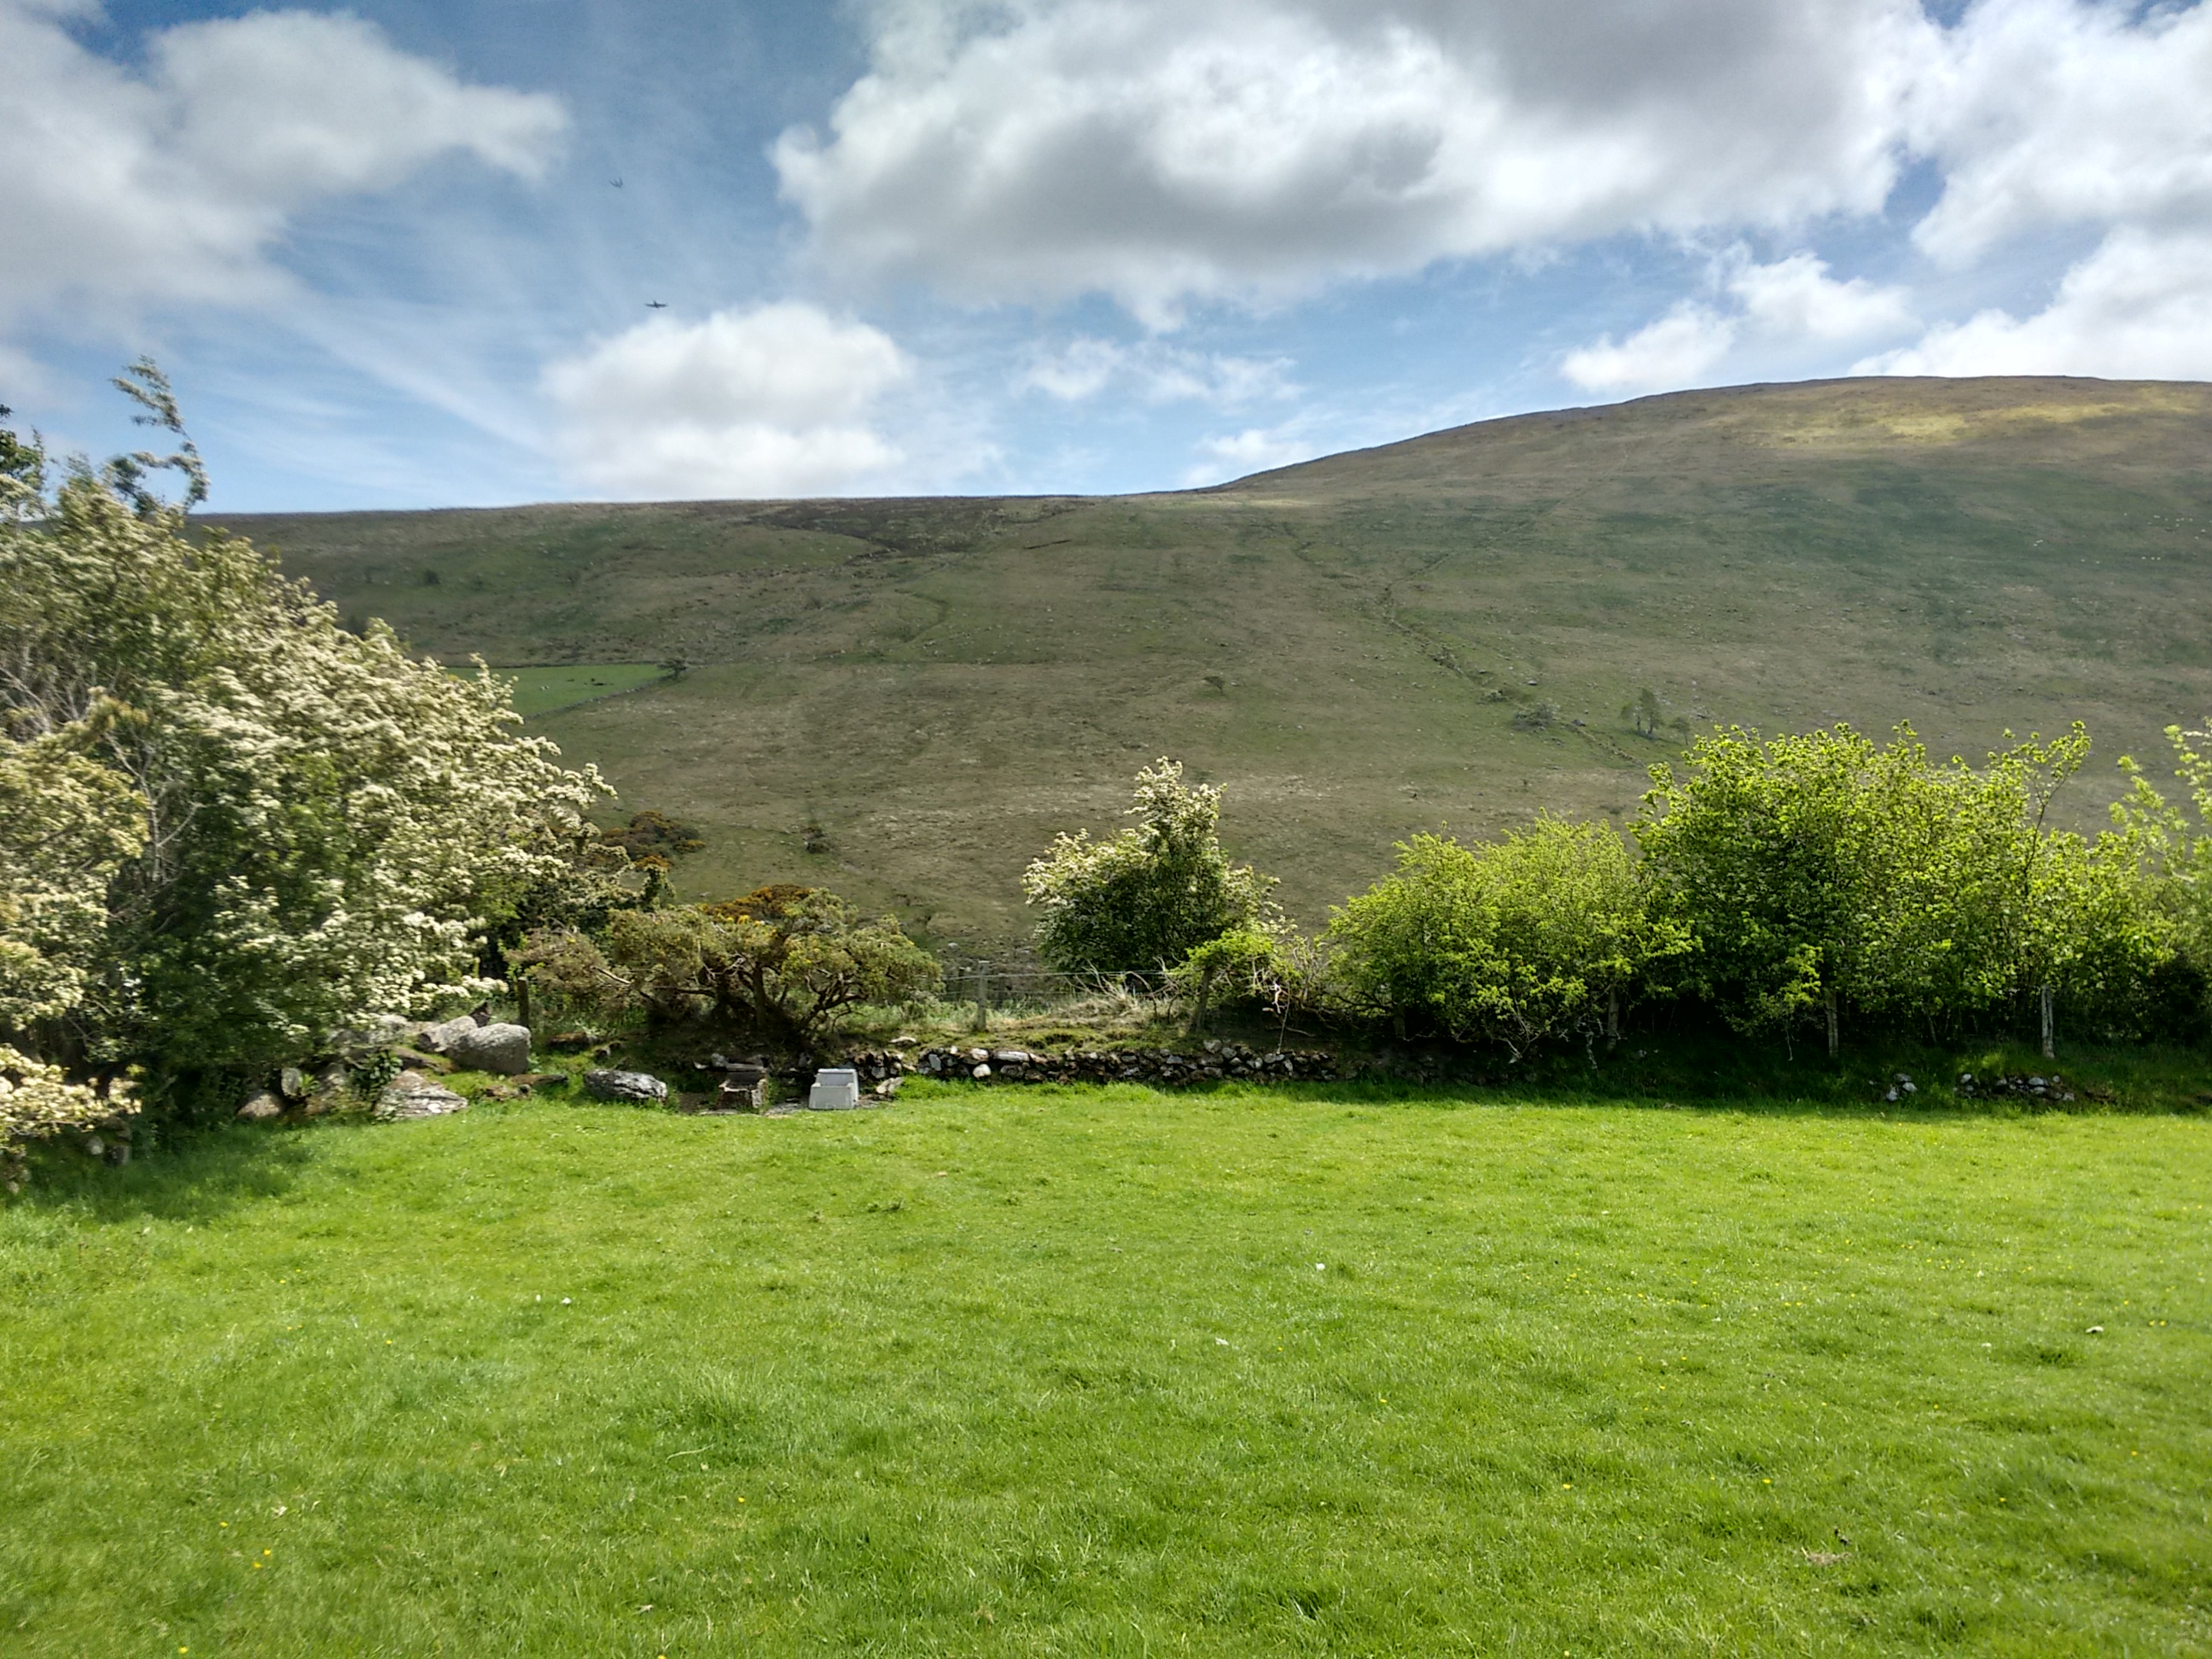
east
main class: Grassland
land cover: Grassland without tree/shrub cover
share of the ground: > 75 %
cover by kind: herbaceous plants 100 %
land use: Agriculture (excluding fallow land and kitchen gardens)
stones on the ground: 25 - 50 %
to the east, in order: Grassland without tree/shrub cover; Abandoned hedges; Dry stone walls; Fences; Grassland without tree/shrub cover; Fences; Dry stone walls; Abandoned hedges; Paved roads, cycling and walking lanes; Abandoned hedges; Fences; Grassland without tree/shrub cover; Fences; Abandoned hedges; Rivers and streams; Grassland with sparse tree/shrub cover
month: June
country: GB
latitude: 54.8724
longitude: -7.0158
